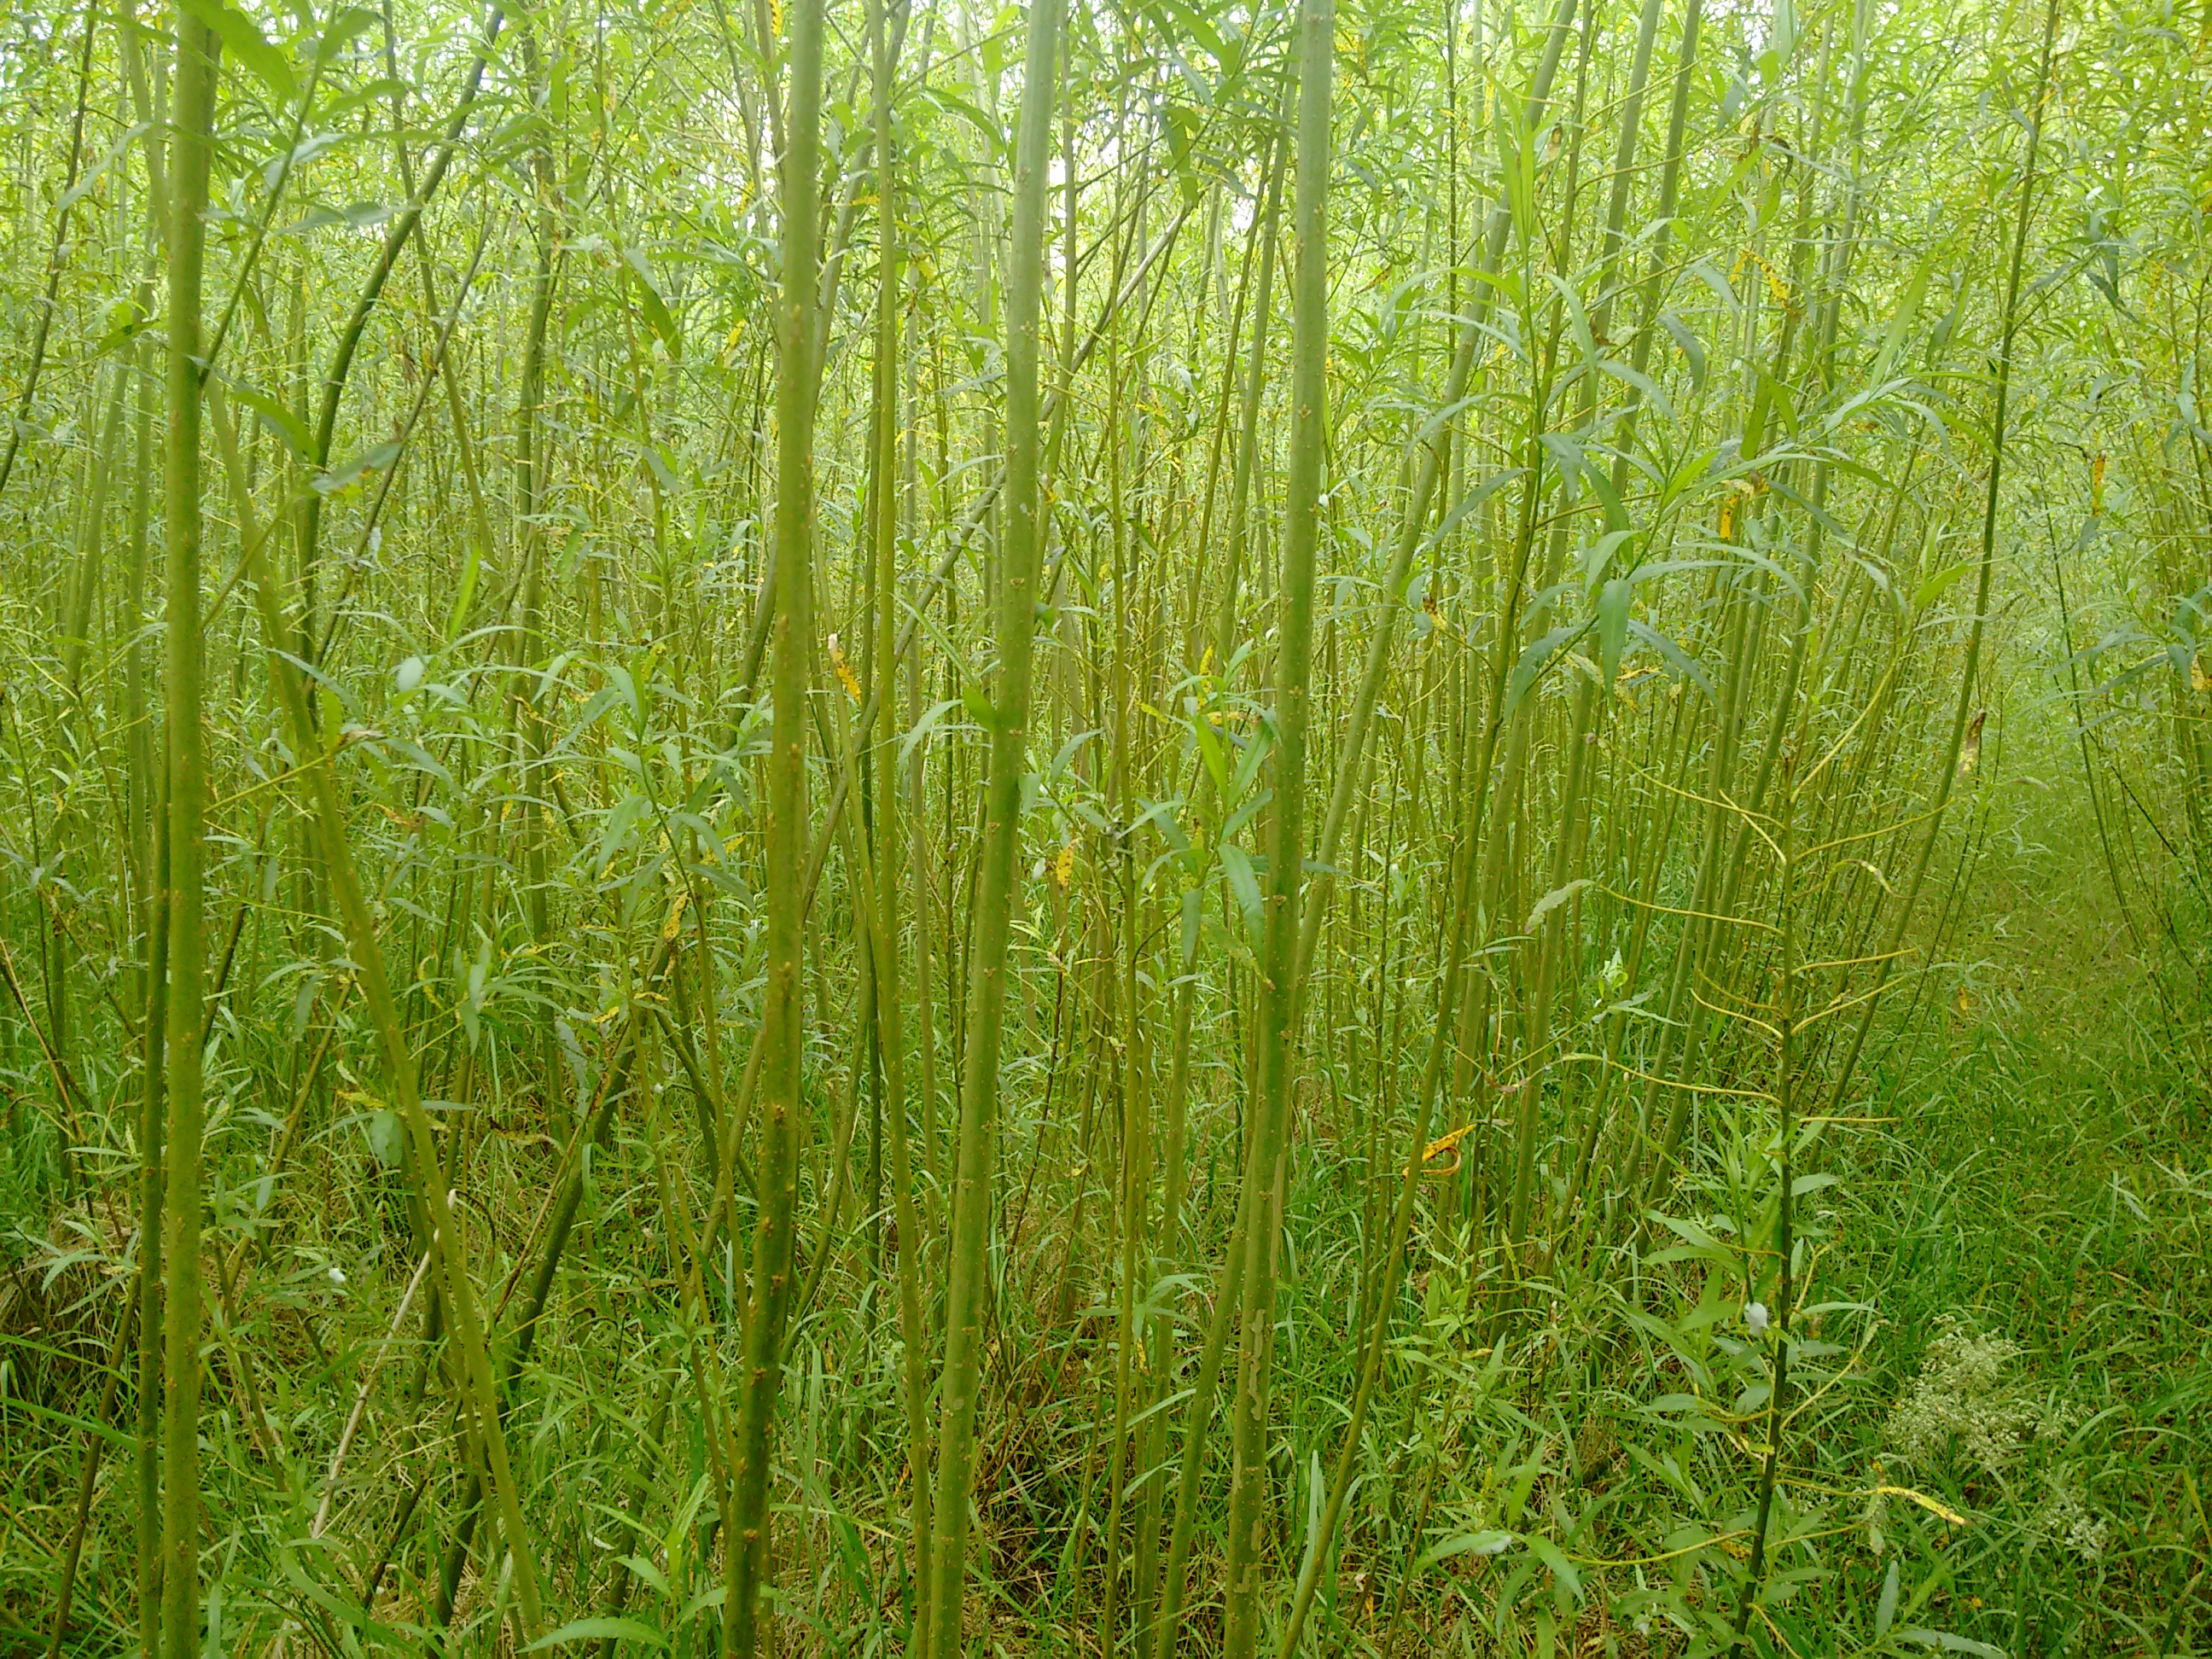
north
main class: Cropland
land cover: Permanent industrial crops
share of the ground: > 75 %
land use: Agriculture (excluding fallow land and kitchen gardens)
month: June
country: IE
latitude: 53.3810
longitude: -7.6469
